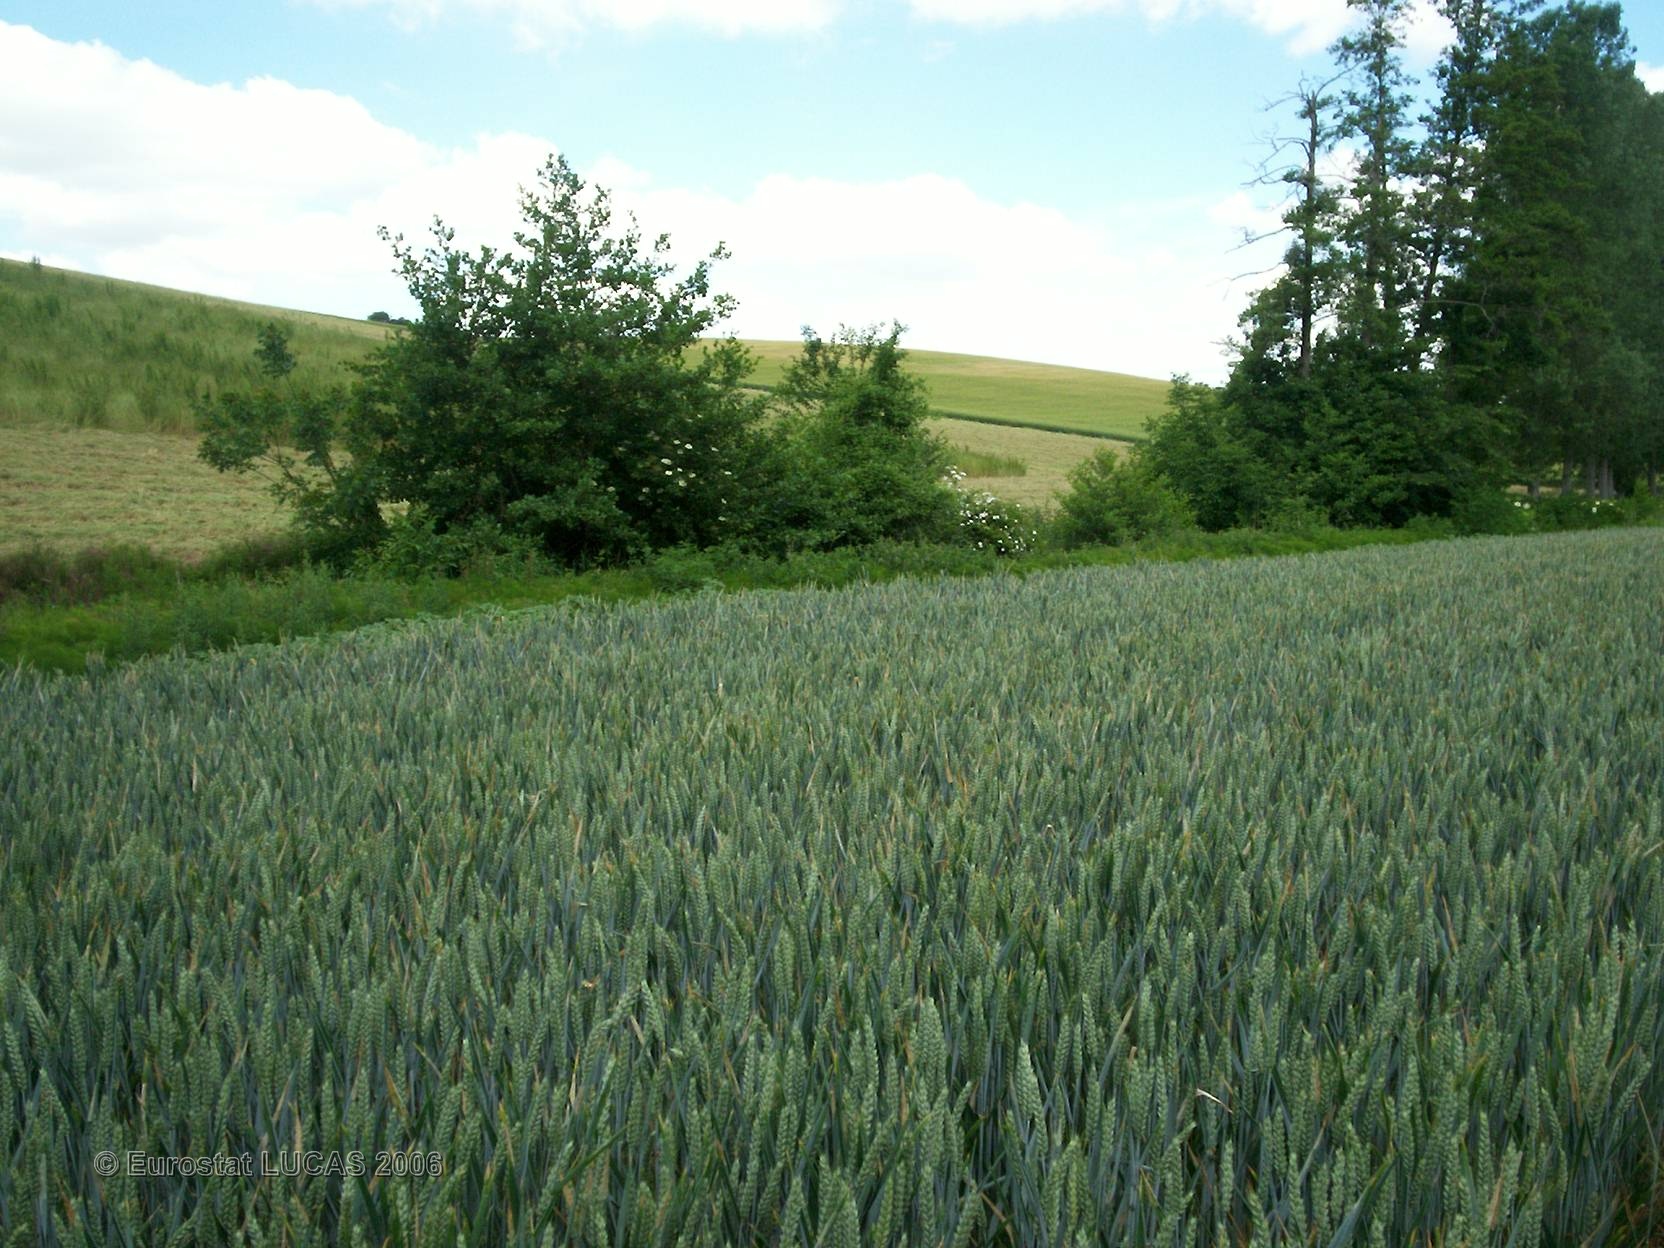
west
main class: Grassland
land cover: Grassland without tree/shrub cover
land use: Agriculture (excluding fallow land and kitchen gardens)
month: May
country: FR
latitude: 43.5039
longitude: 0.9844
